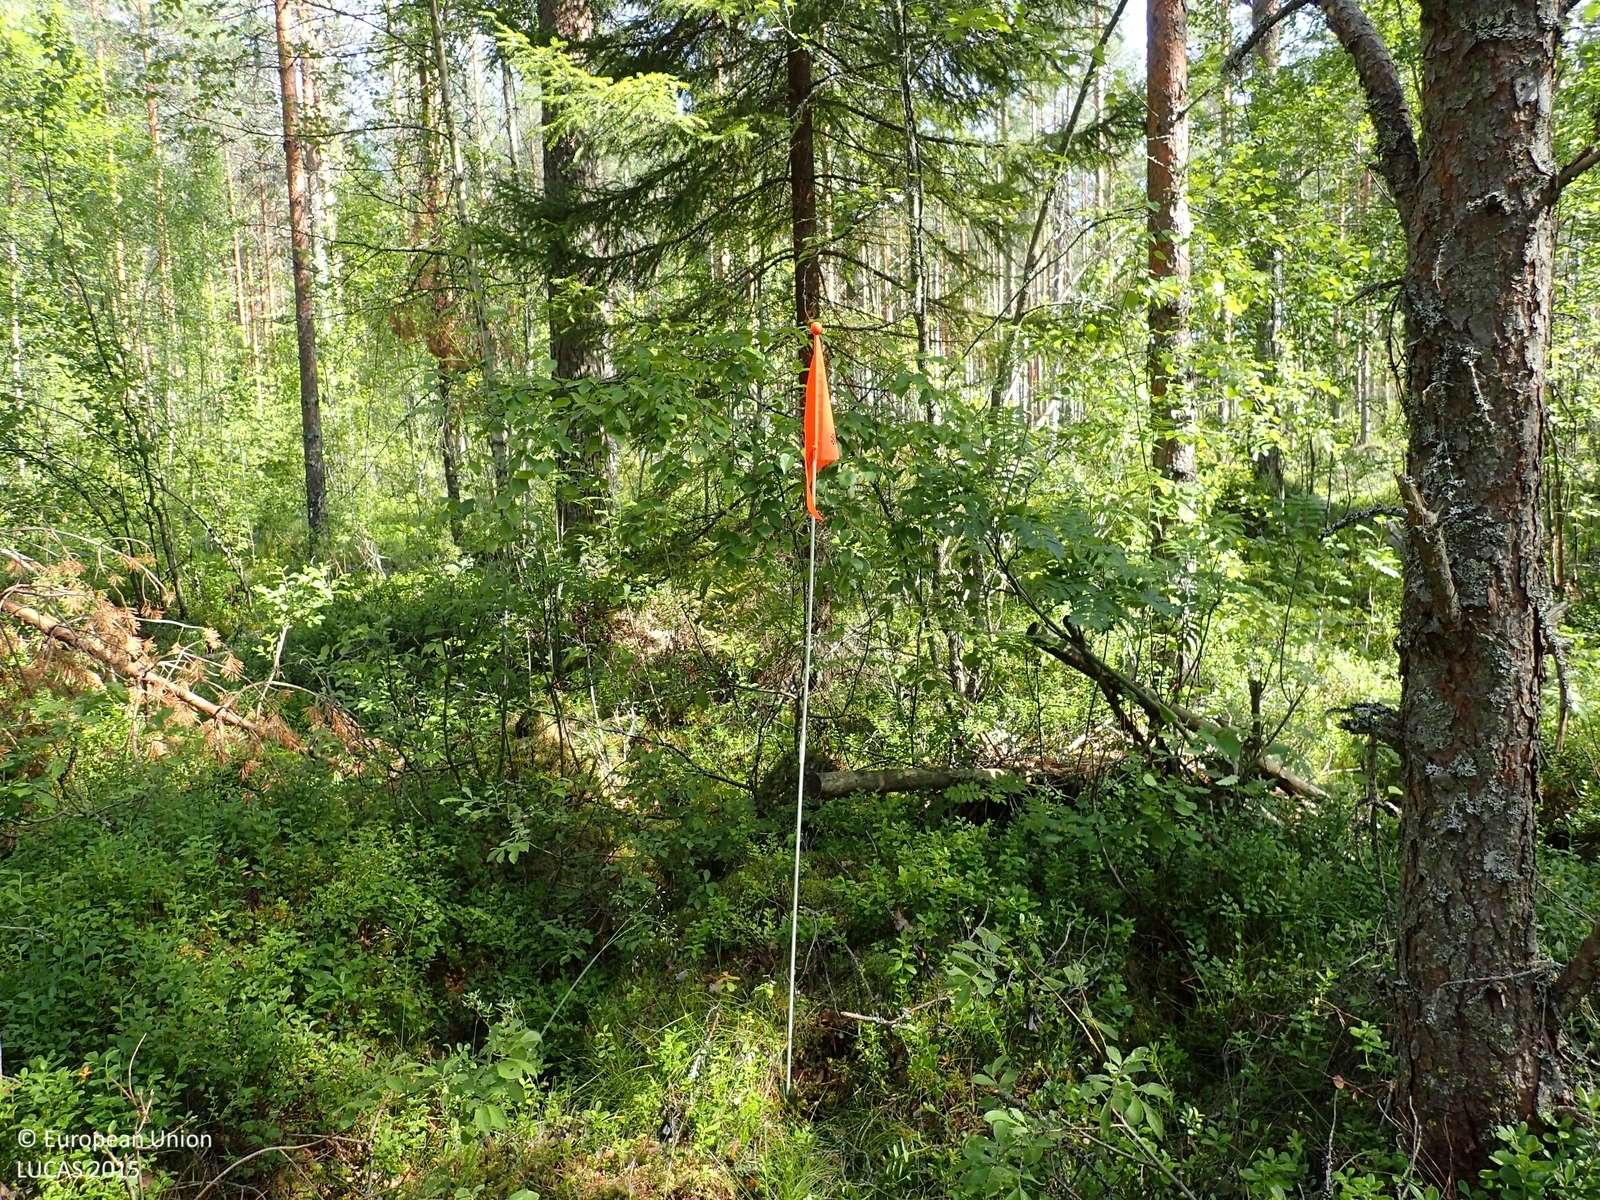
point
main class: Woodland
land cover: Pine dominated coniferous woodland
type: boreal forest
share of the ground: 50 - 75 %
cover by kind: coniferous forest trees 55 %, shrubs 30 %, broadleaved forest trees 10 %, herbaceous plants 5 %
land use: Forestry
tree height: > 5 m
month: July
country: FI
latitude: 62.9241
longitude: 23.6378
